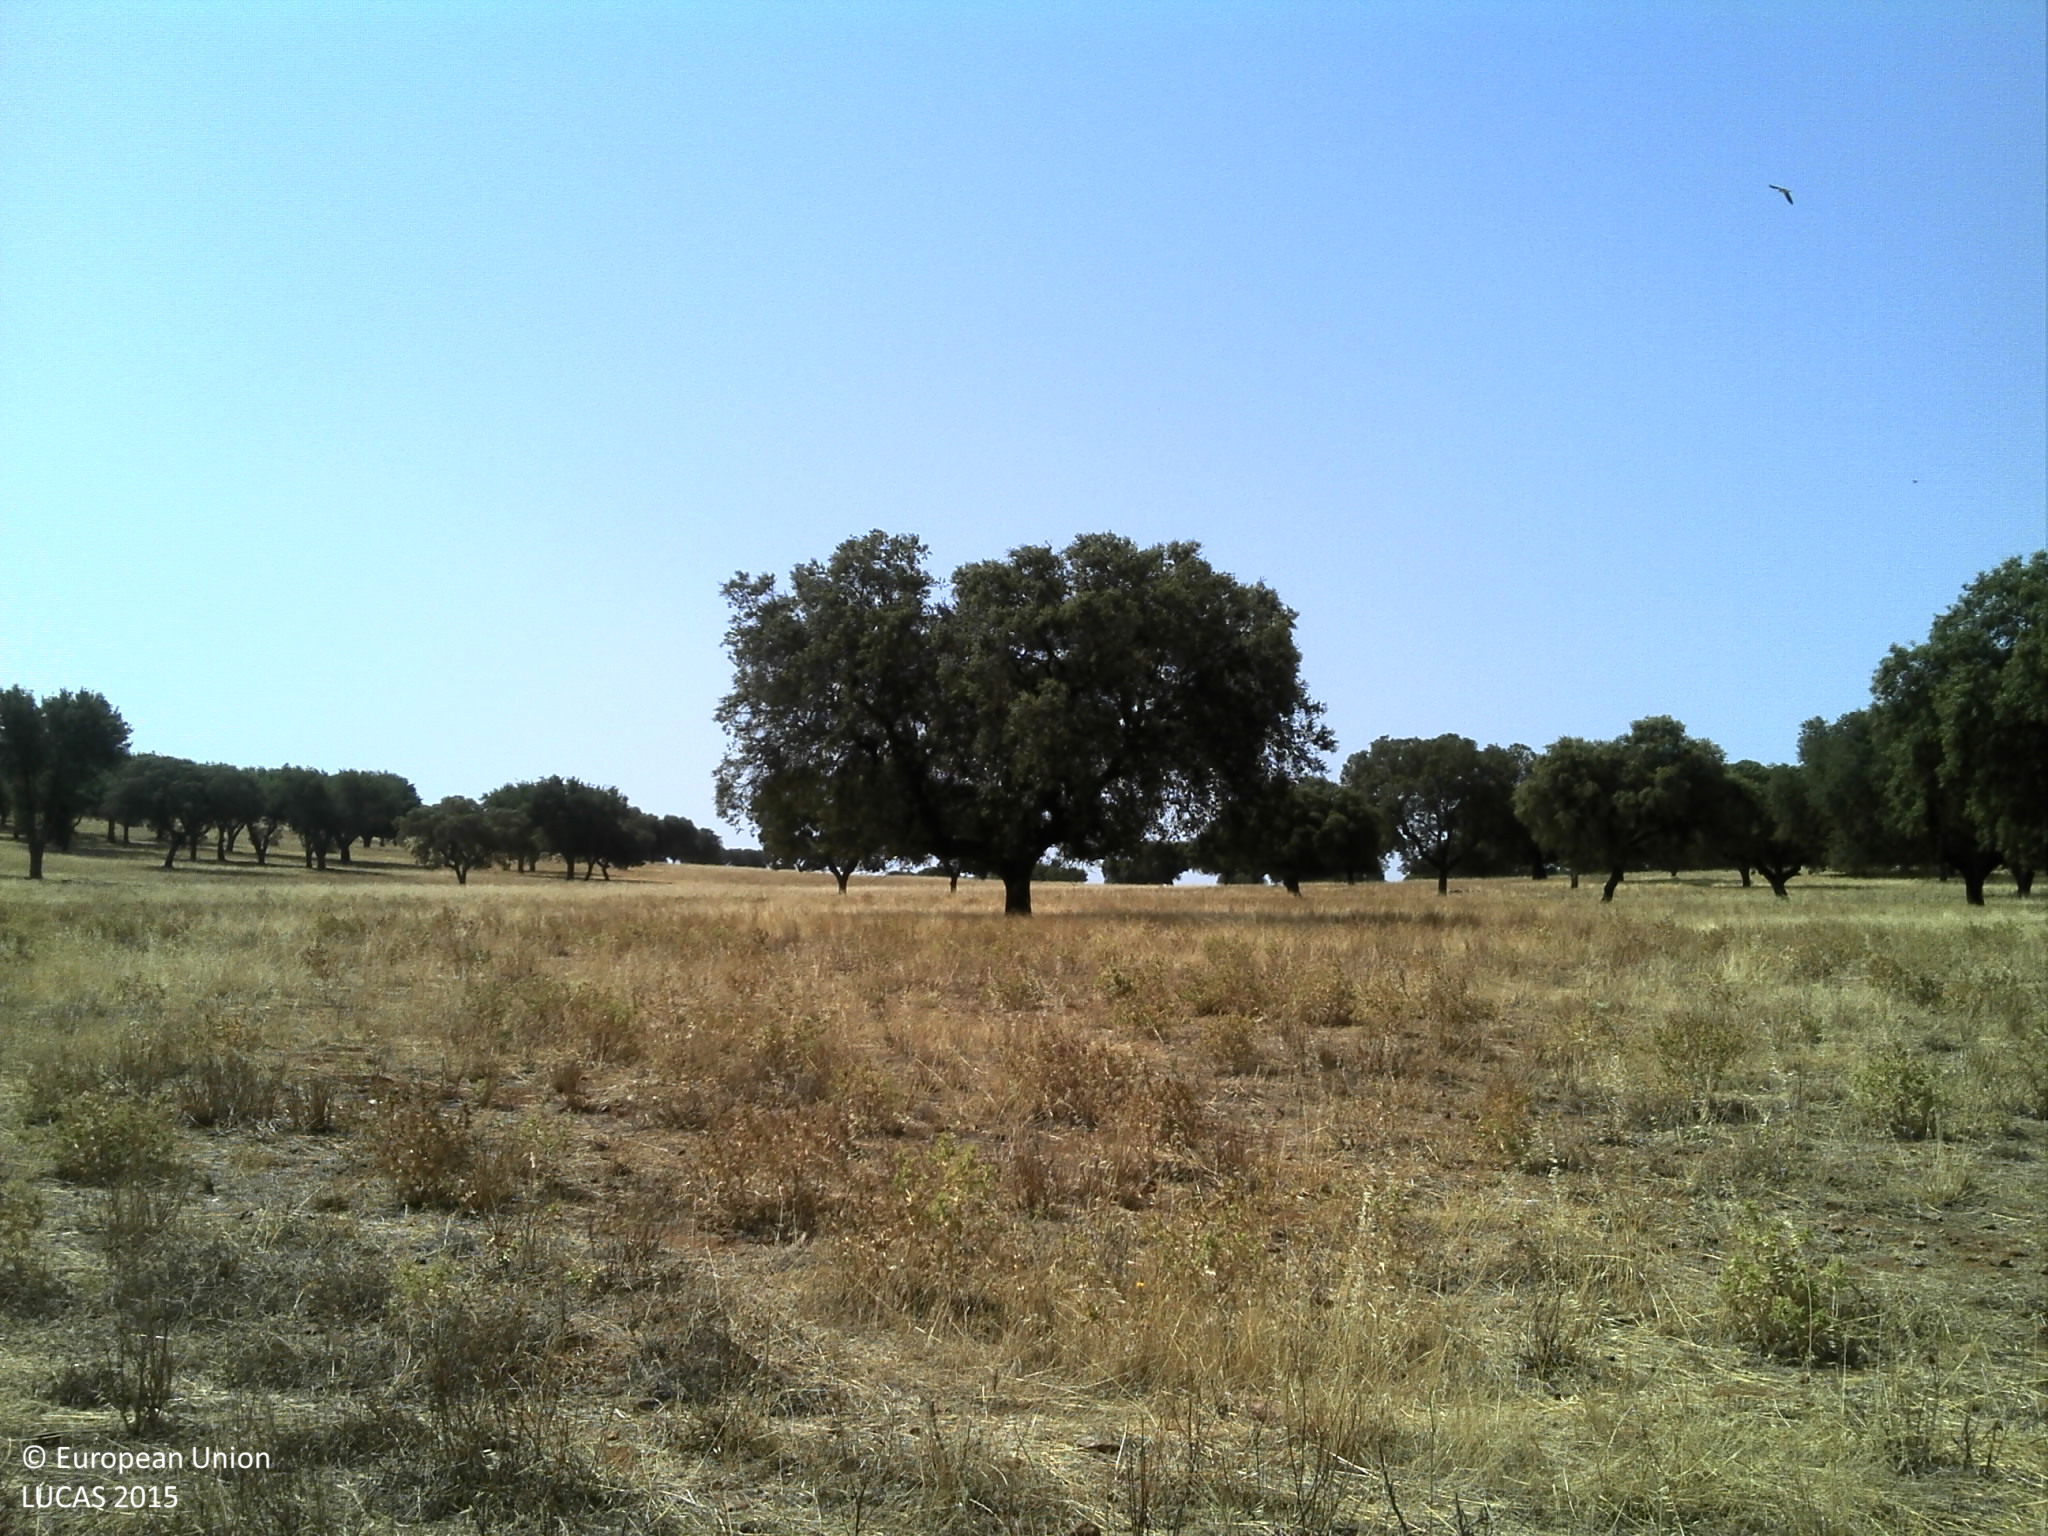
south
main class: Grassland
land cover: Spontaneously vegetated surfaces
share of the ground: 25 - 50 %
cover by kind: unconsolidated bare surface 70 %, herbaceous plants 30 %
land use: Agriculture (excluding fallow land and kitchen gardens)
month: July
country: PT
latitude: 38.7335
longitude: -7.4129
